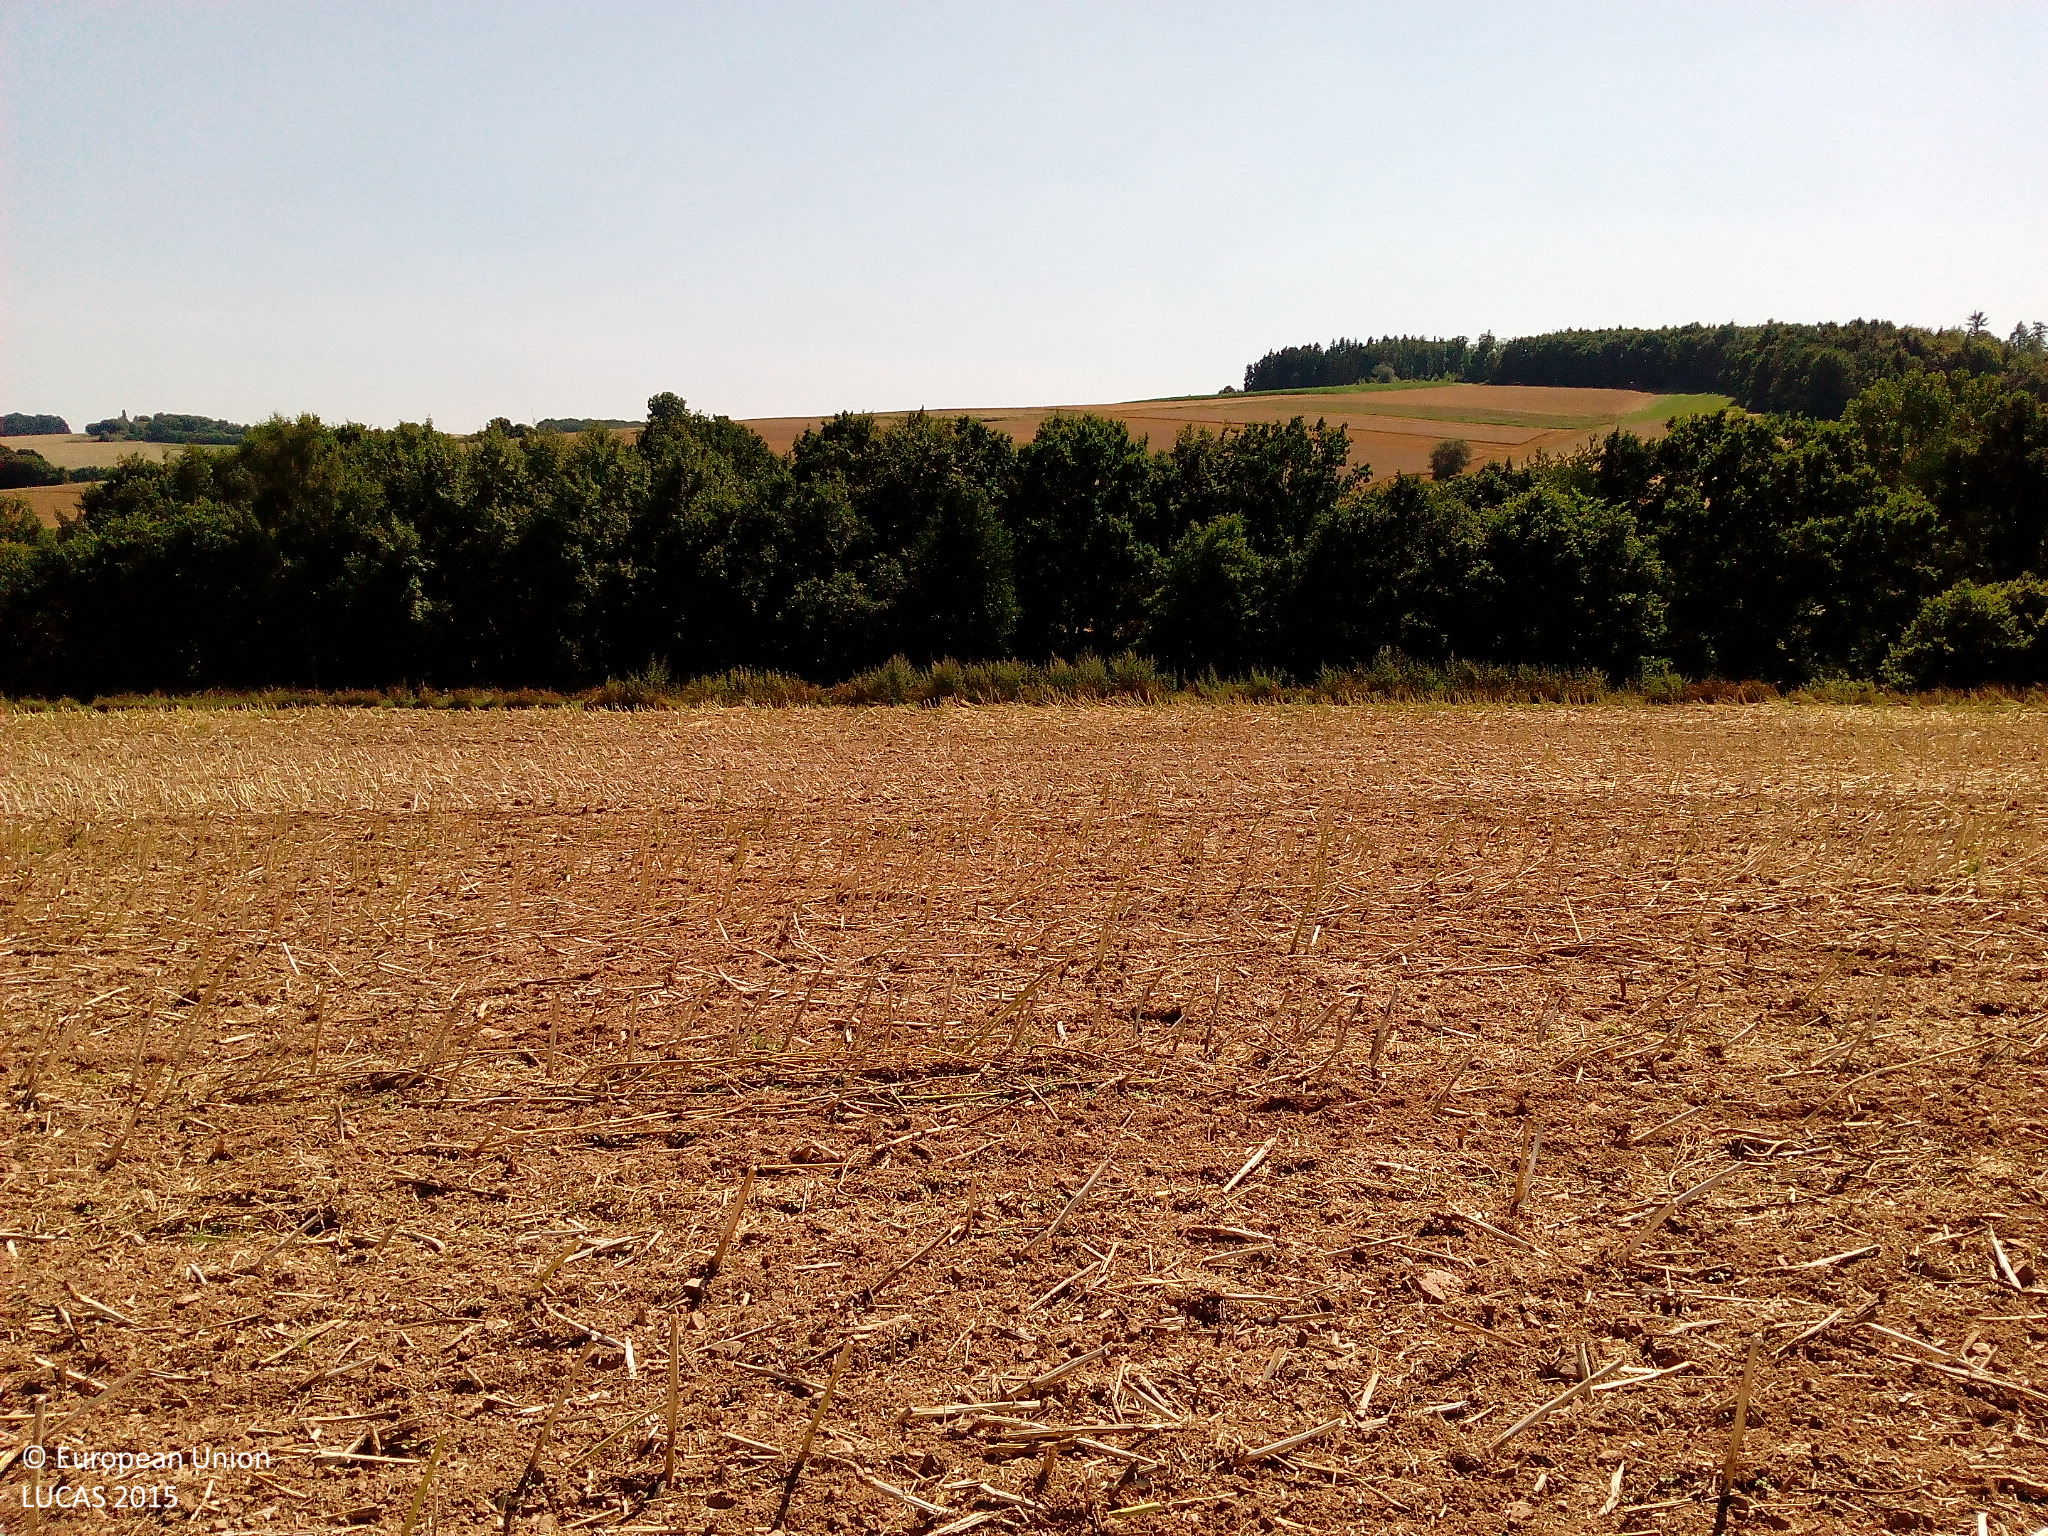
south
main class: Cropland
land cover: Rape and turnip rape
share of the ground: 10 - 25 %
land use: Agriculture (excluding fallow land and kitchen gardens)
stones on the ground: < 10 %
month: August
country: DE
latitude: 50.8111
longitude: 9.2480
